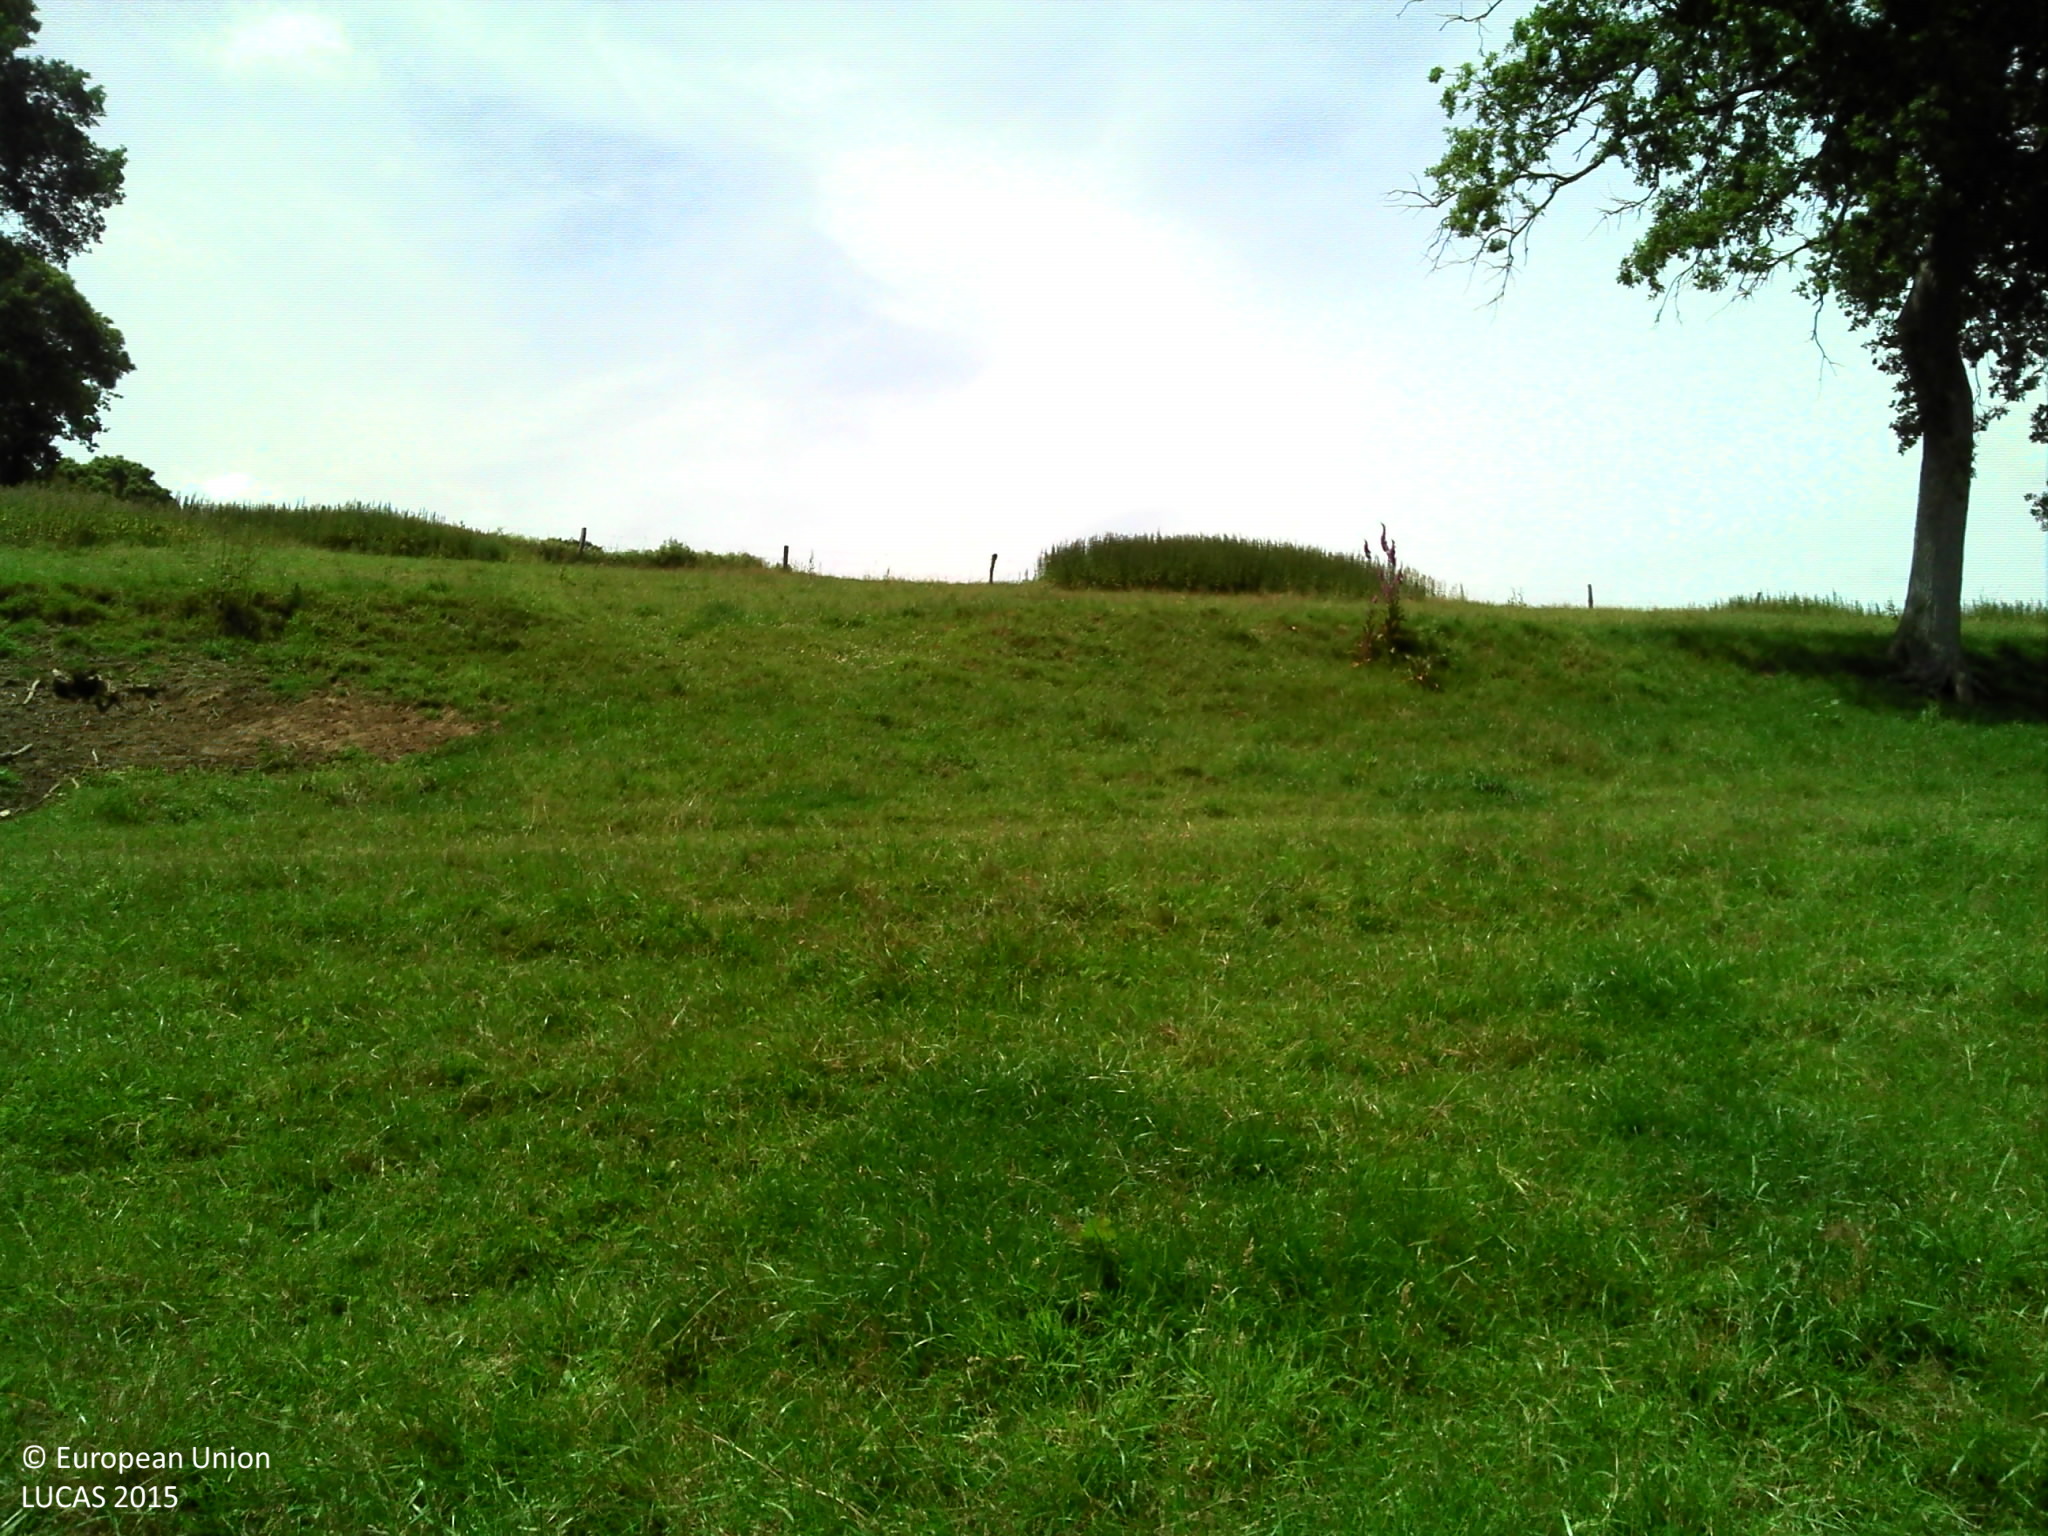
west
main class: Grassland
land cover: Grassland without tree/shrub cover
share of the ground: > 75 %
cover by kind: herbaceous plants 100 %
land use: Agriculture (excluding fallow land and kitchen gardens)
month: June
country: FR
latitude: 48.3817
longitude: -1.5102
